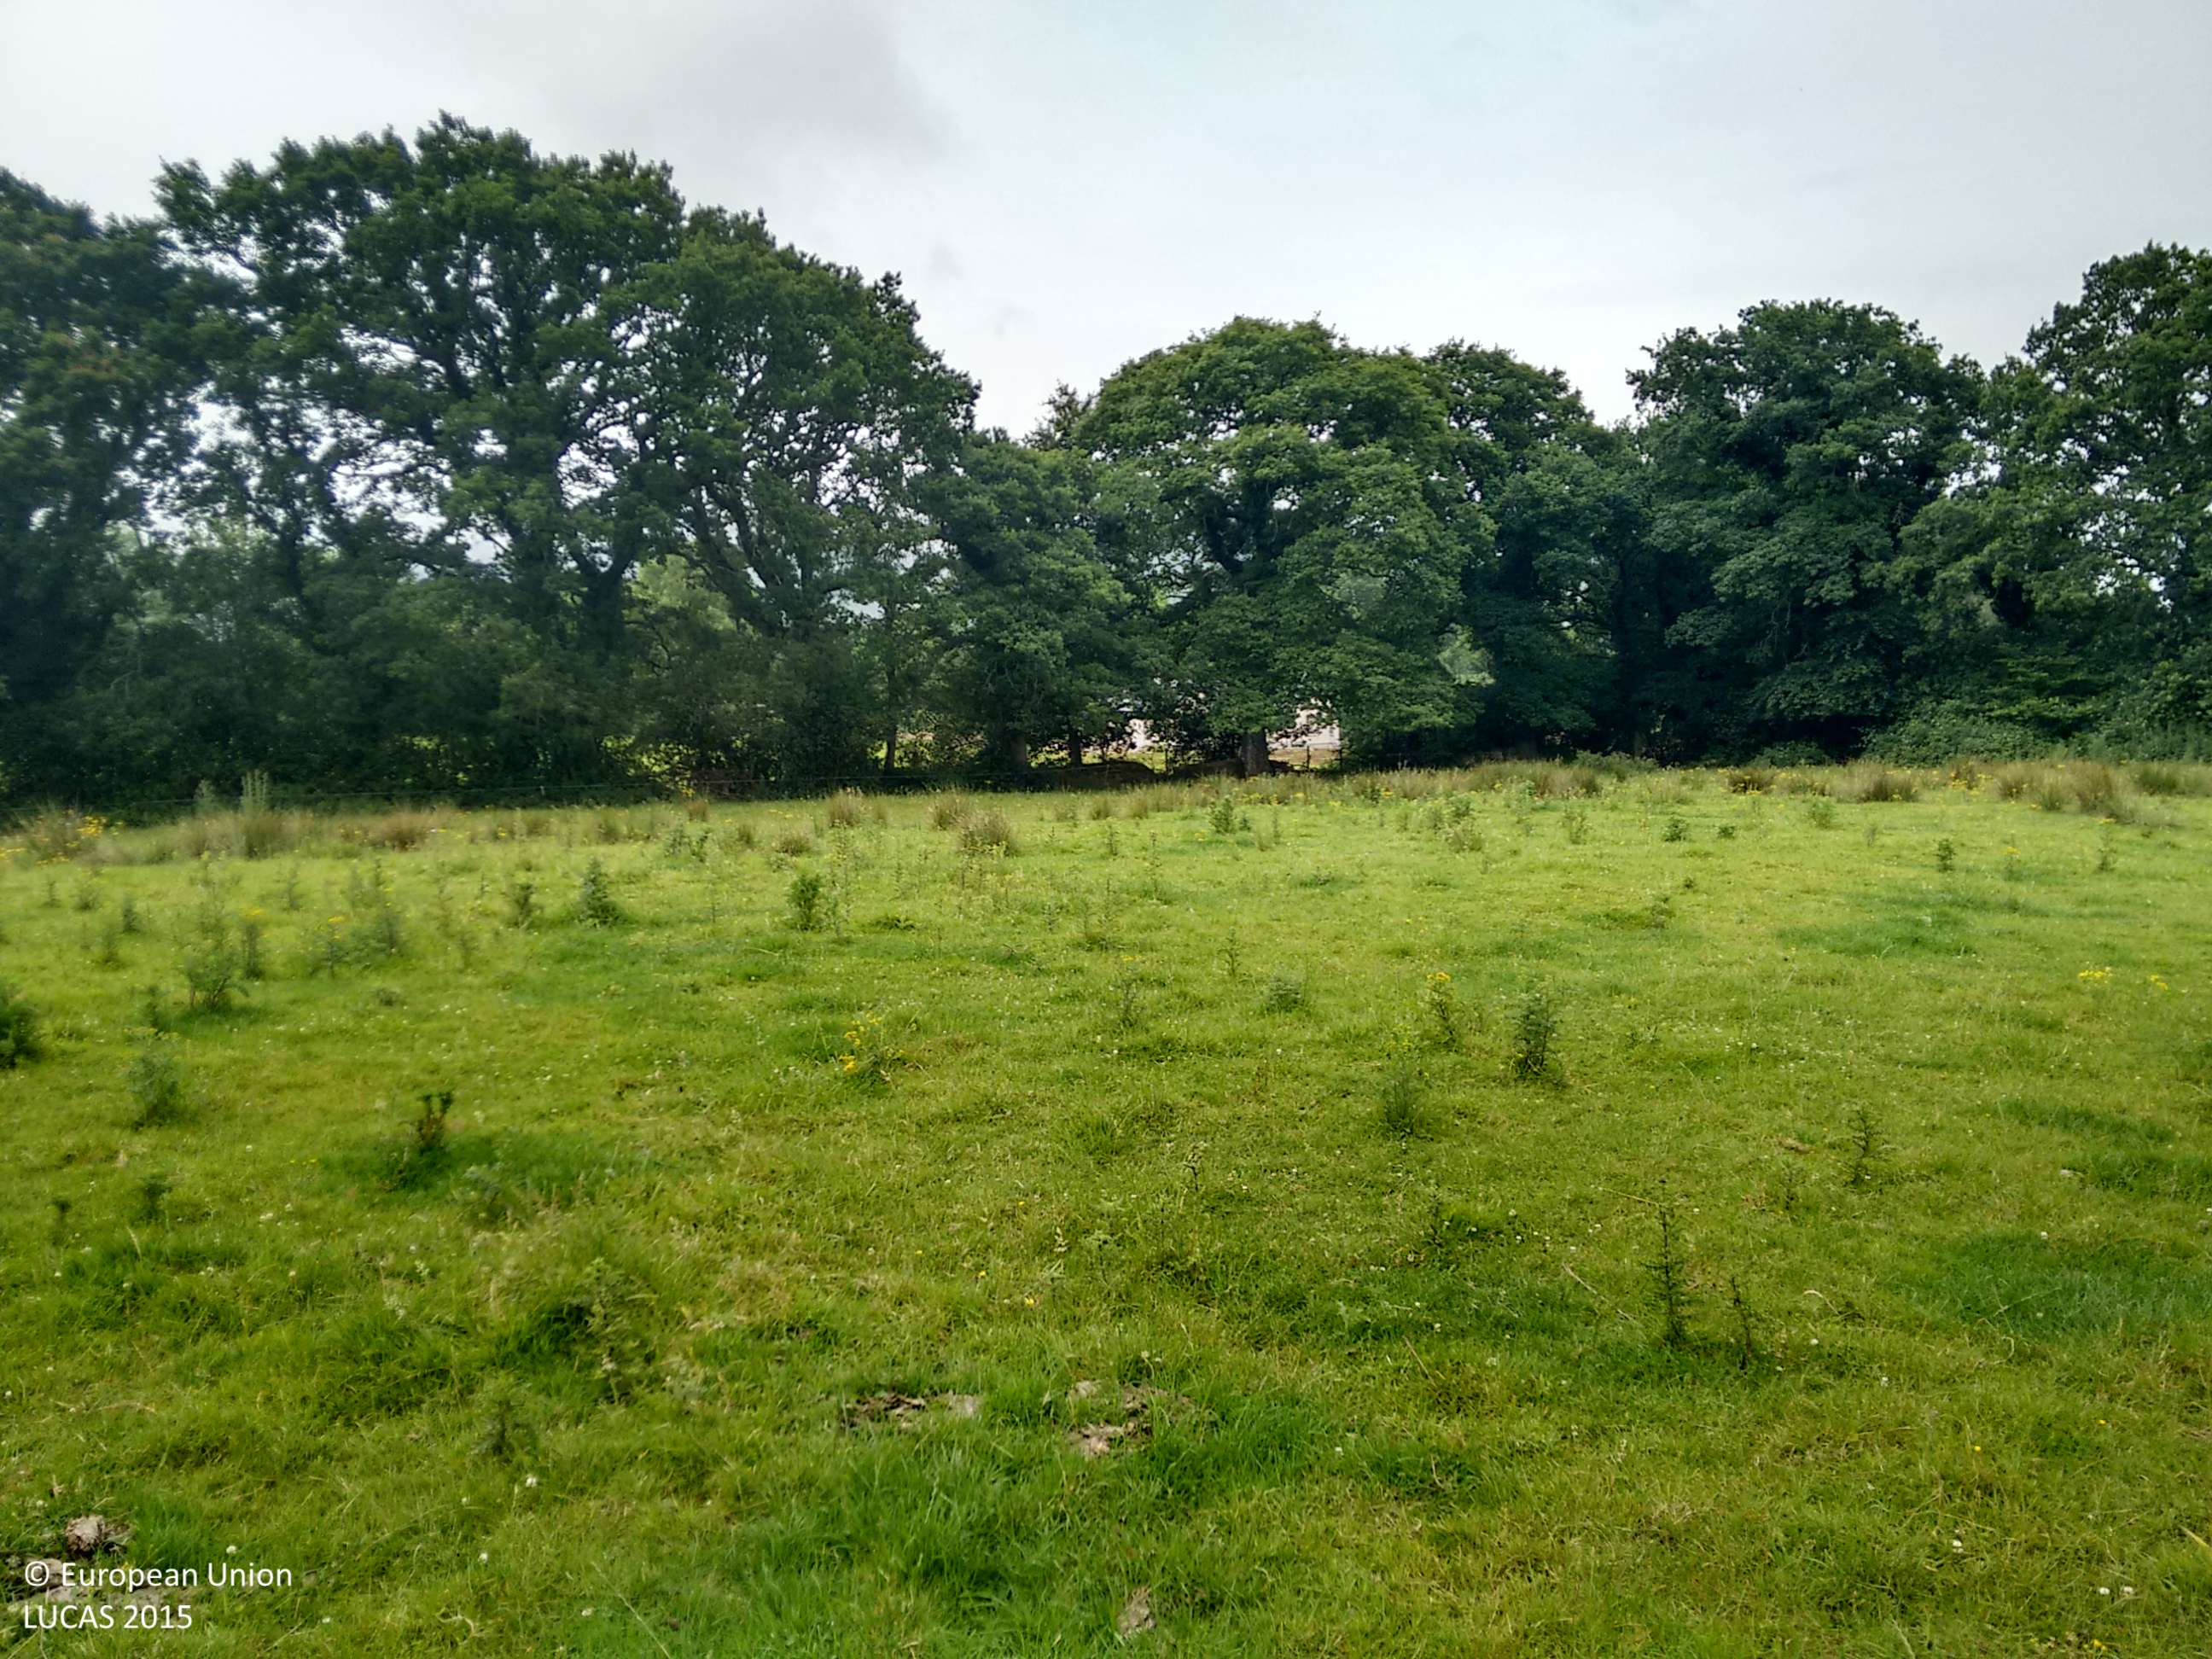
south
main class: Grassland
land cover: Grassland without tree/shrub cover
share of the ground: > 75 %
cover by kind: herbaceous plants 100 %
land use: Agriculture (excluding fallow land and kitchen gardens)
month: July
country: IE
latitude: 52.4123
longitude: -8.1922
